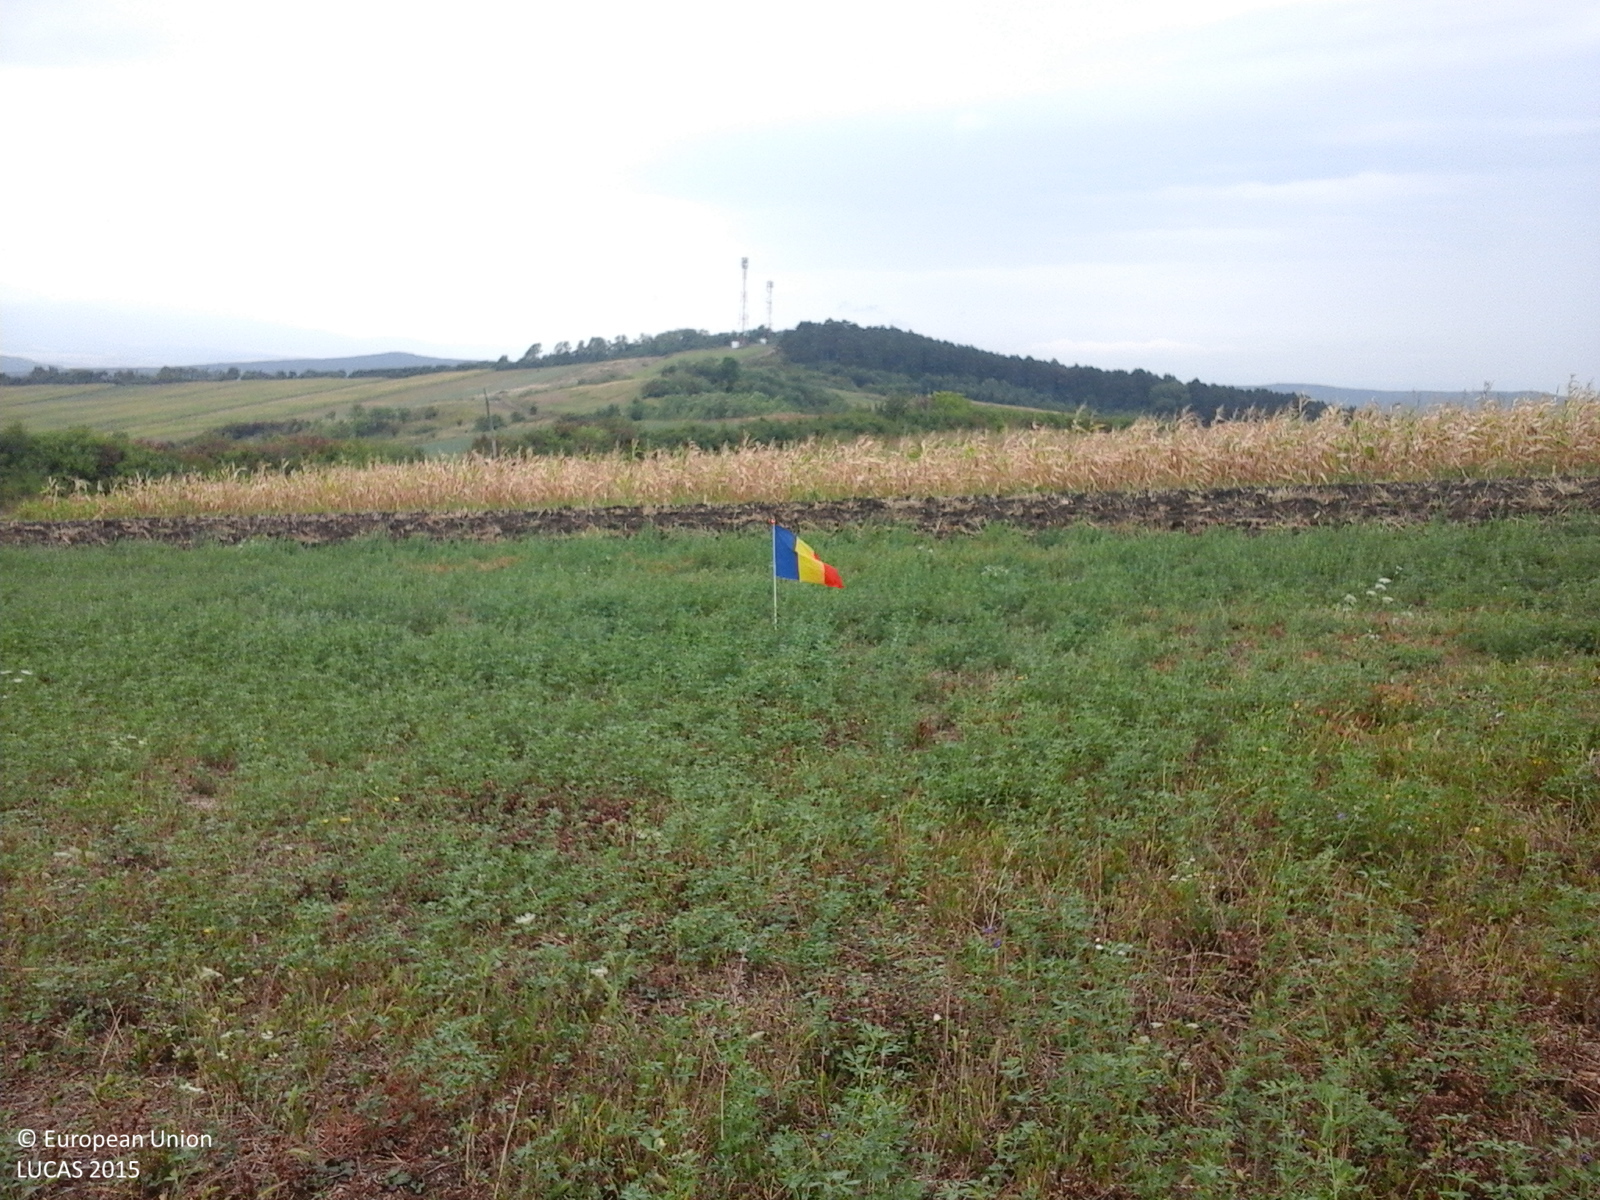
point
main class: Cropland
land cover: Lucerne
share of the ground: > 75 %
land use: Agriculture (excluding fallow land and kitchen gardens)
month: September
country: RO
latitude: 47.2463
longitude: 23.0249
